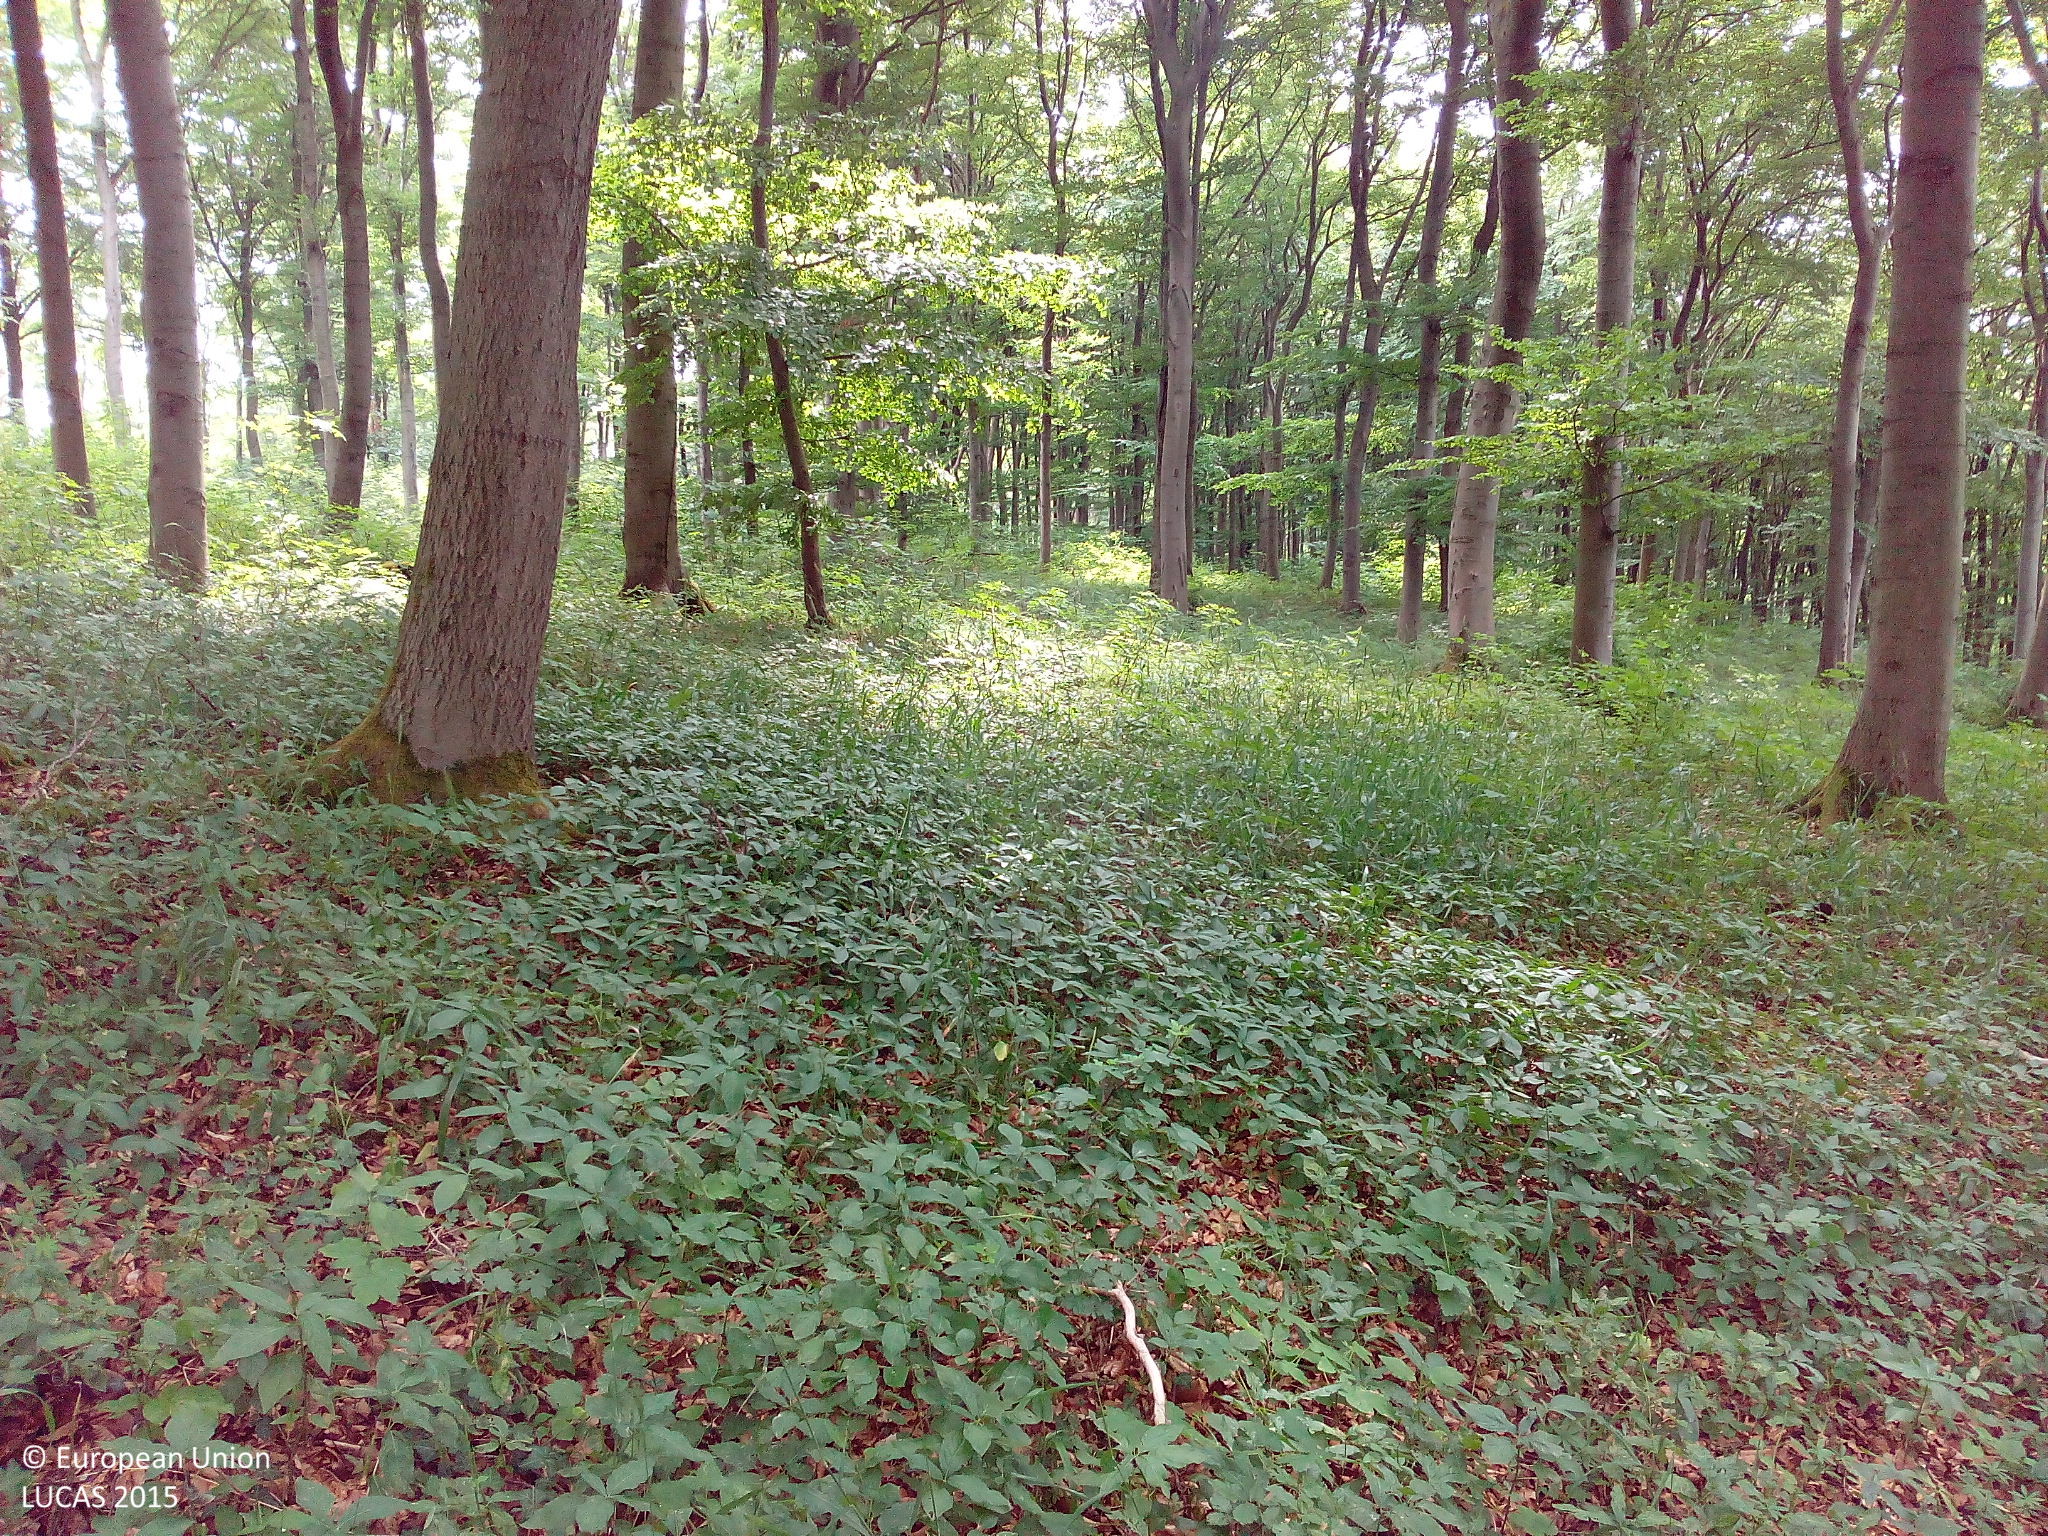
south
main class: Woodland
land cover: Broadleaved woodland
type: beech forest
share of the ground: > 75 %
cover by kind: broadleaved forest trees 90 %, herbaceous plants 10 %
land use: Forestry
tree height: > 5 m
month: July
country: DE
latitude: 50.8314
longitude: 9.8723
